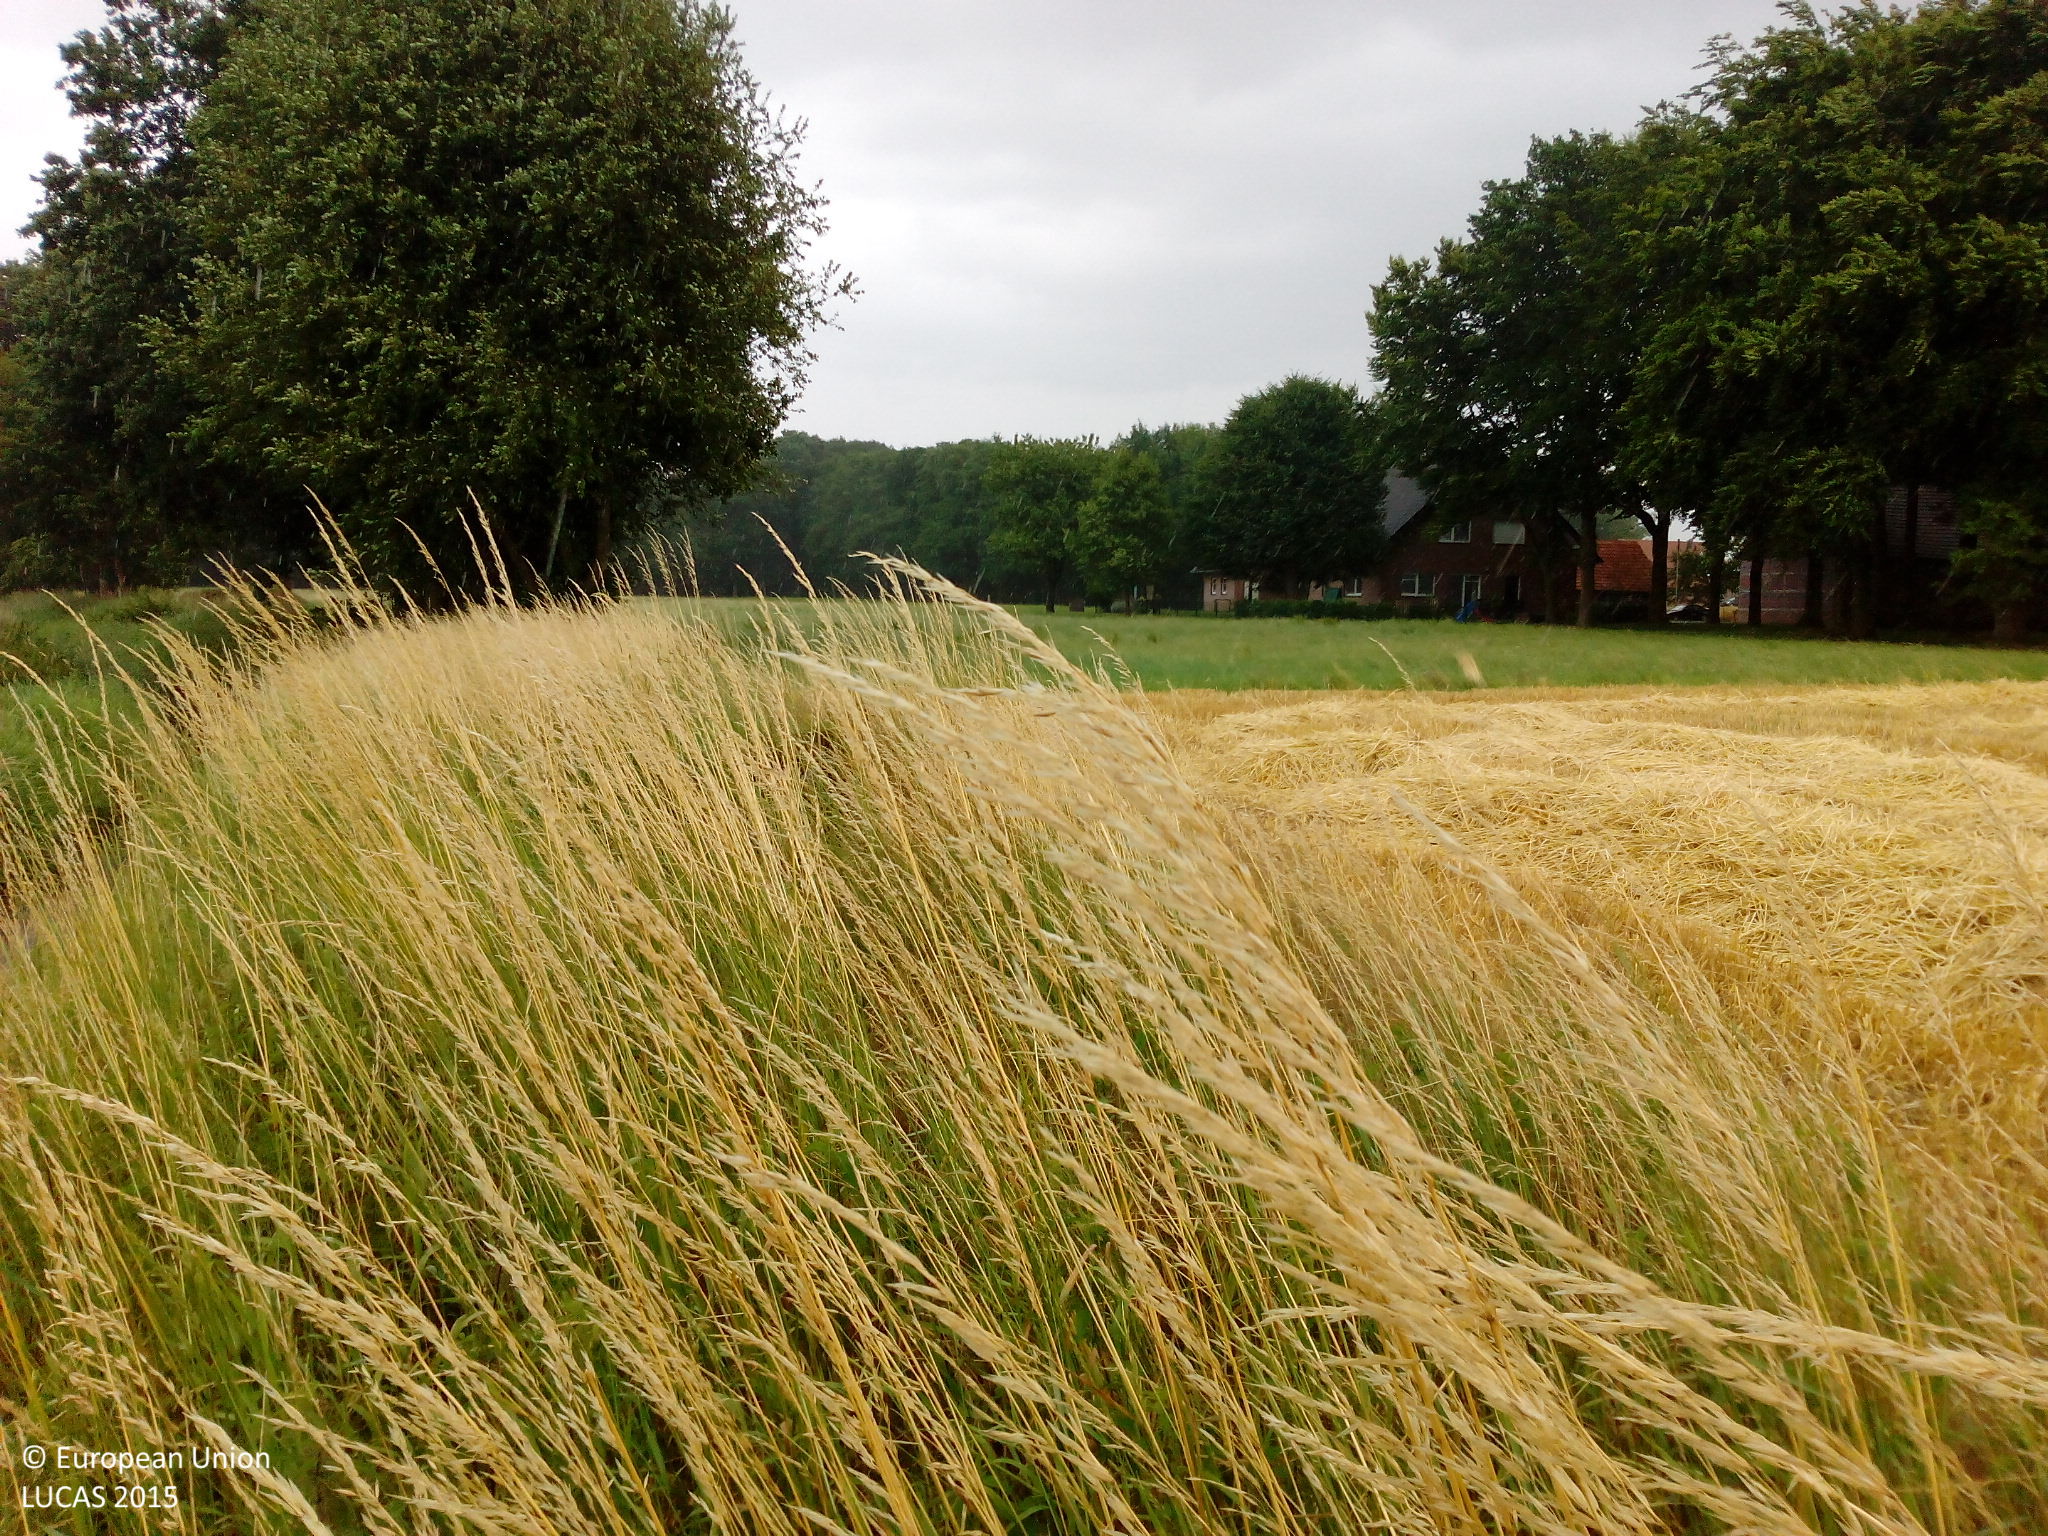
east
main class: Cropland
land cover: Maize
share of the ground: > 75 %
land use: Agriculture (excluding fallow land and kitchen gardens)
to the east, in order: Maize; Shruby margins; Rivers and streams; Shruby margins; Lines of trees; Grassland without tree/shrub cover; Broadleaved woodland; Grassland without tree/shrub cover
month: July
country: DE
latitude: 51.7935
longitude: 8.5650
